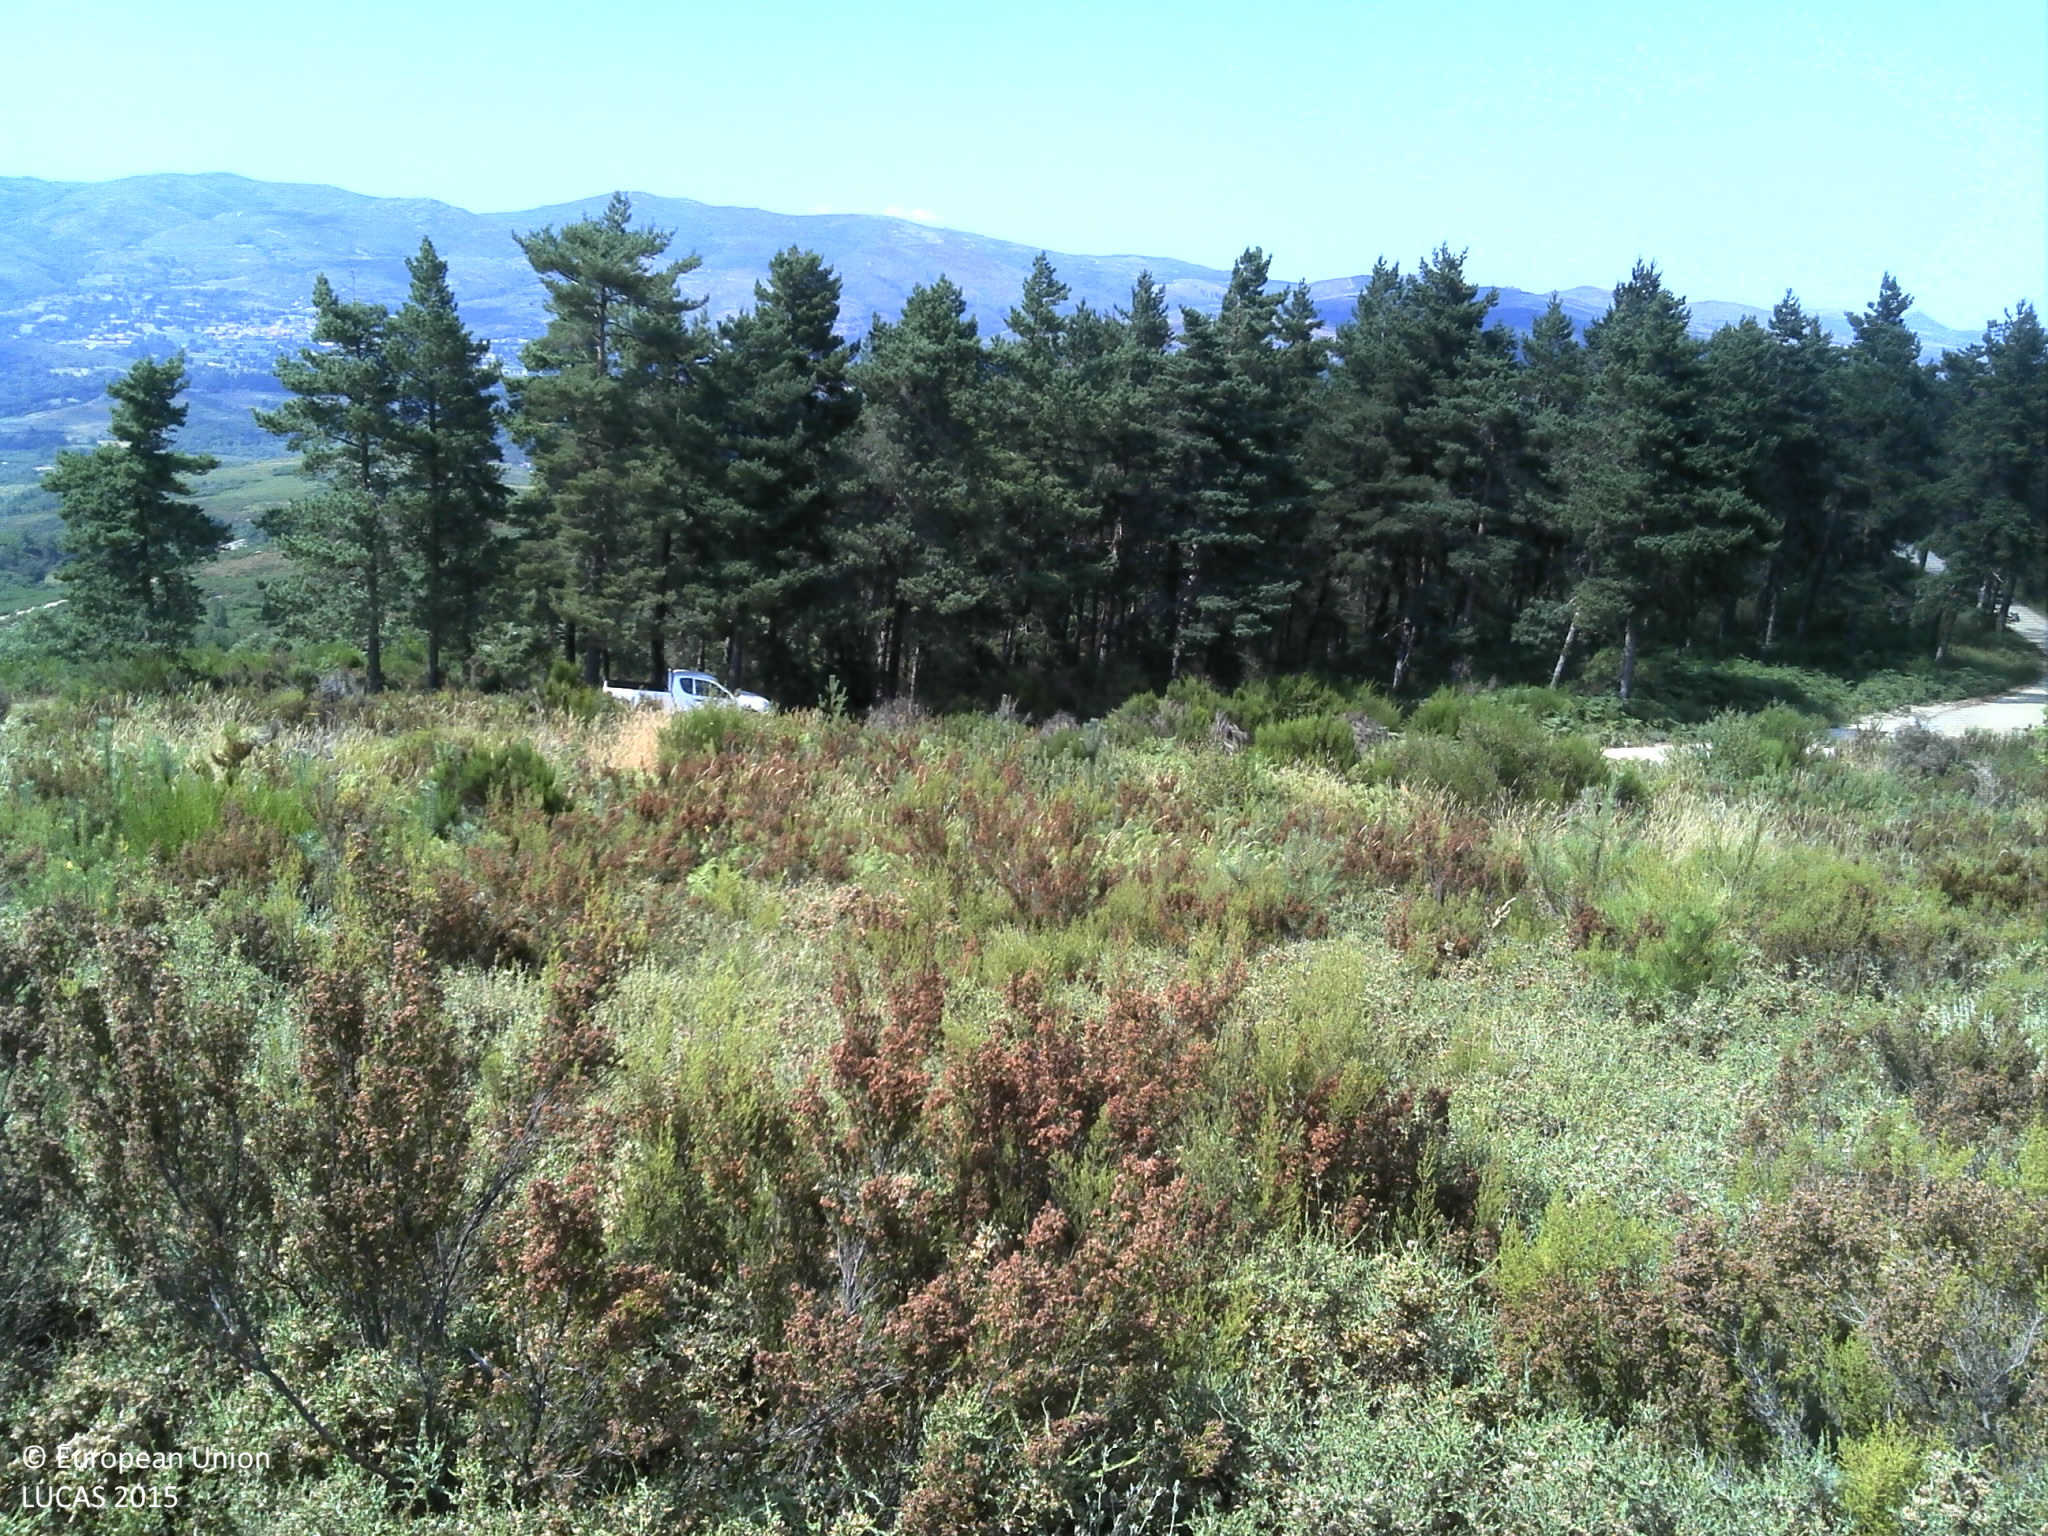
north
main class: Shrubland
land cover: Shrubland without tree cover
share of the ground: > 75 %
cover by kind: shrubs 90 %, consolidated bare surface 5 %, unconsolidated bare surface 5 %
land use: Semi-natural and natural areas not in use
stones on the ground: < 10 %
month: July
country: PT
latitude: 41.7968
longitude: -7.8193
